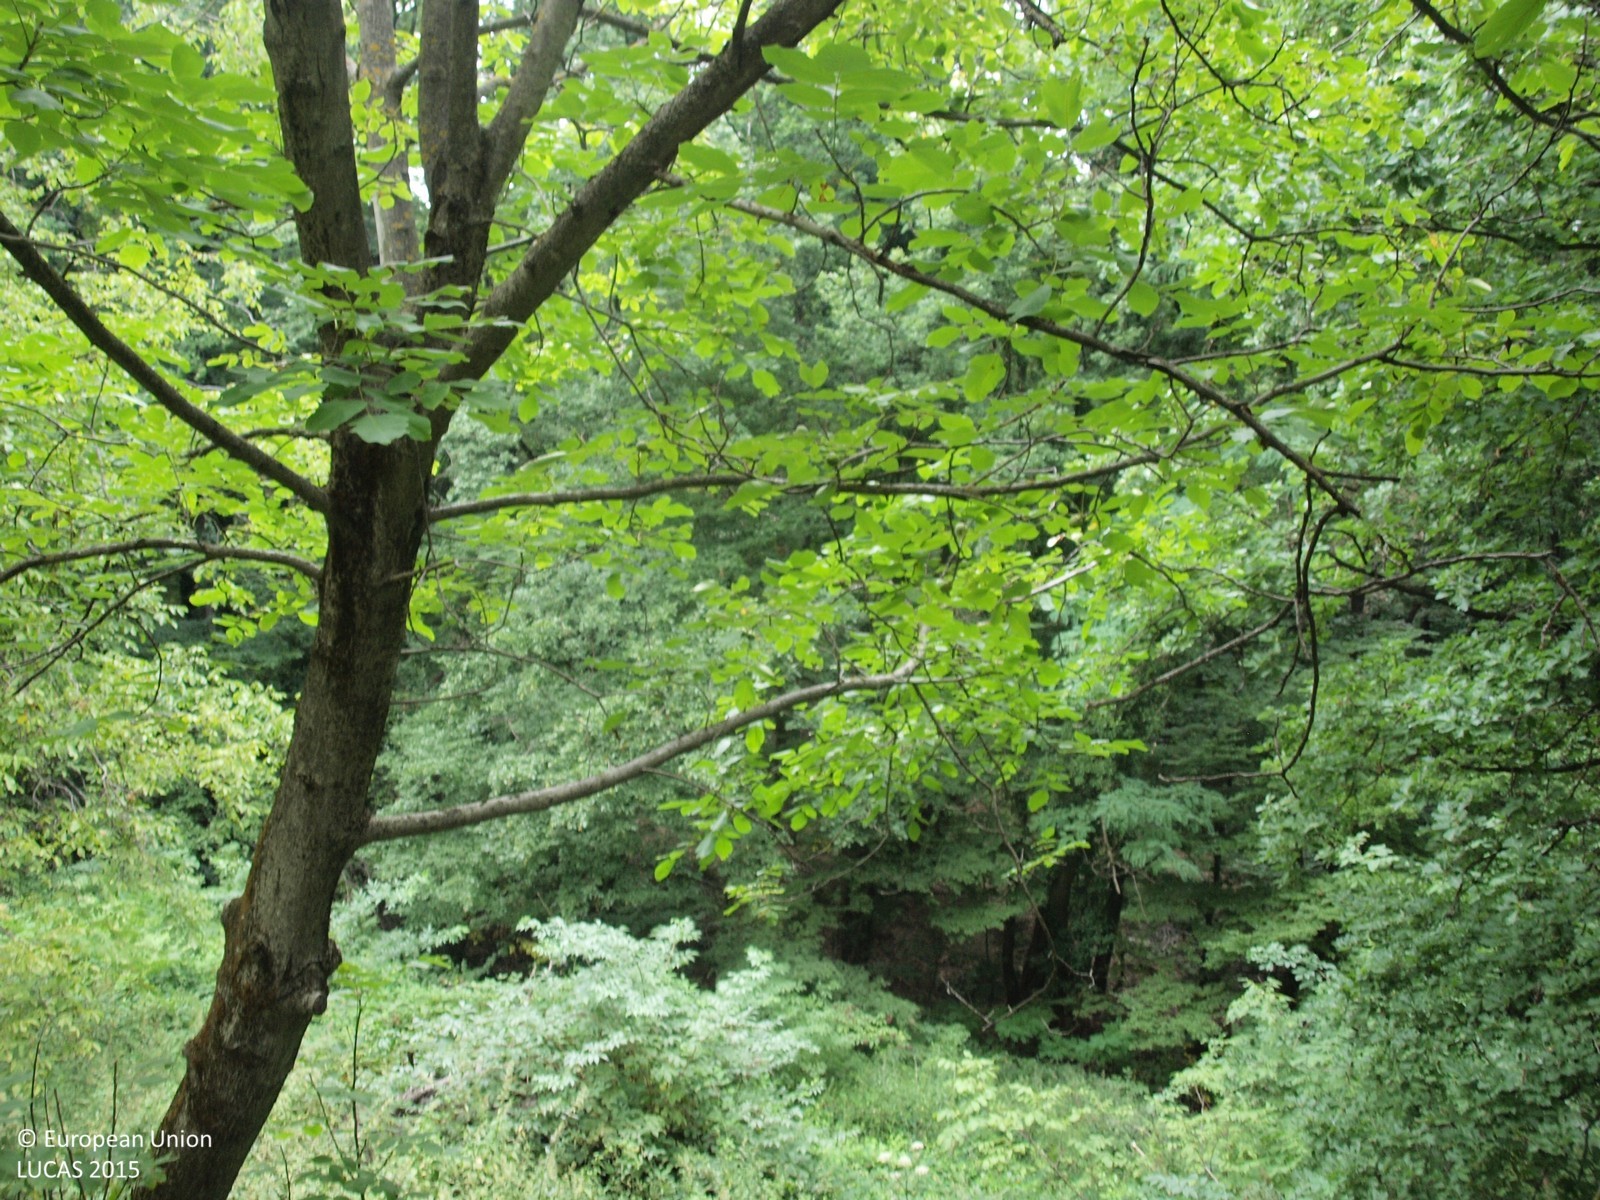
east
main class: Cropland
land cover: Nuts trees
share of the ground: 50 - 75 %
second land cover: Grassland without tree/shrub cover
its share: > 75 %
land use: Agriculture (excluding fallow land and kitchen gardens)
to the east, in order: Nuts trees; Grassland without tree/shrub cover; Broadleaved woodland; Artificial constructions in urban areas
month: August
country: HR
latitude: 45.8419
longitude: 15.9594
